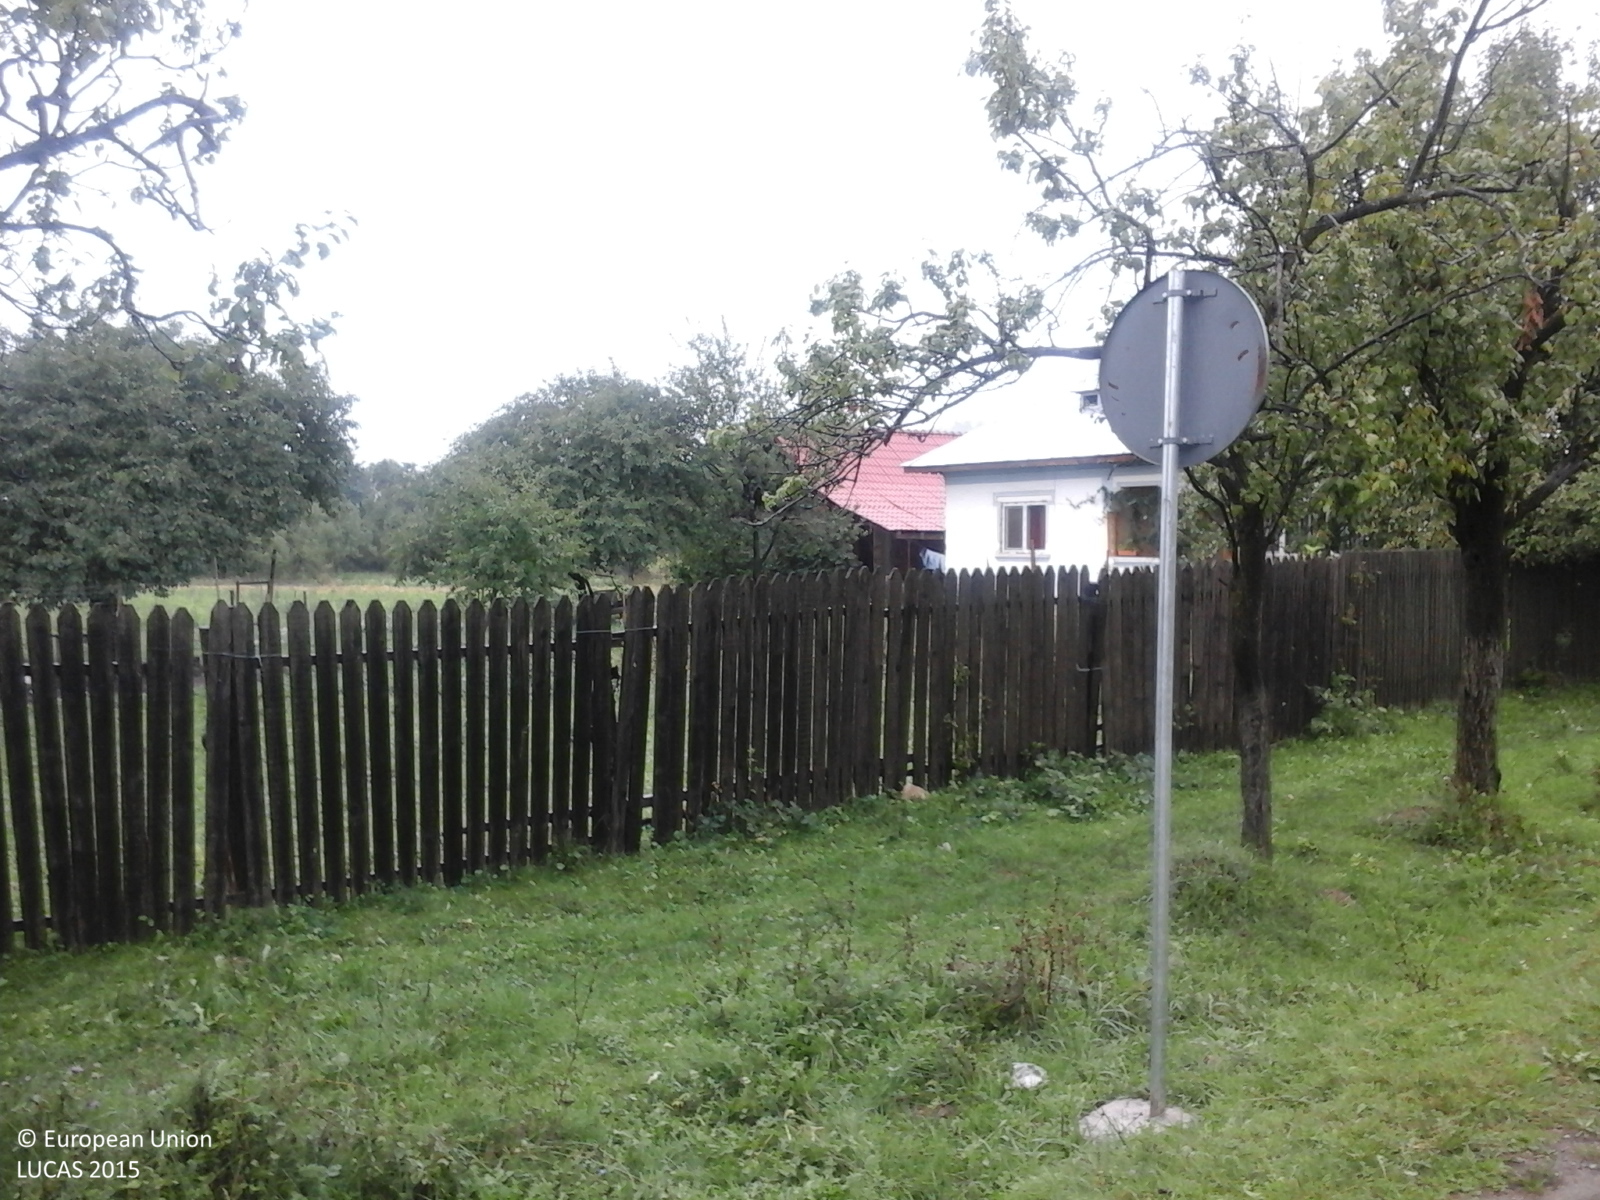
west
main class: Grassland
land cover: Spontaneously vegetated surfaces
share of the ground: > 75 %
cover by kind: herbaceous plants 100 %
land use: Agriculture (excluding fallow land and kitchen gardens)
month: September
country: RO
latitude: 45.1783
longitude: 23.7944
